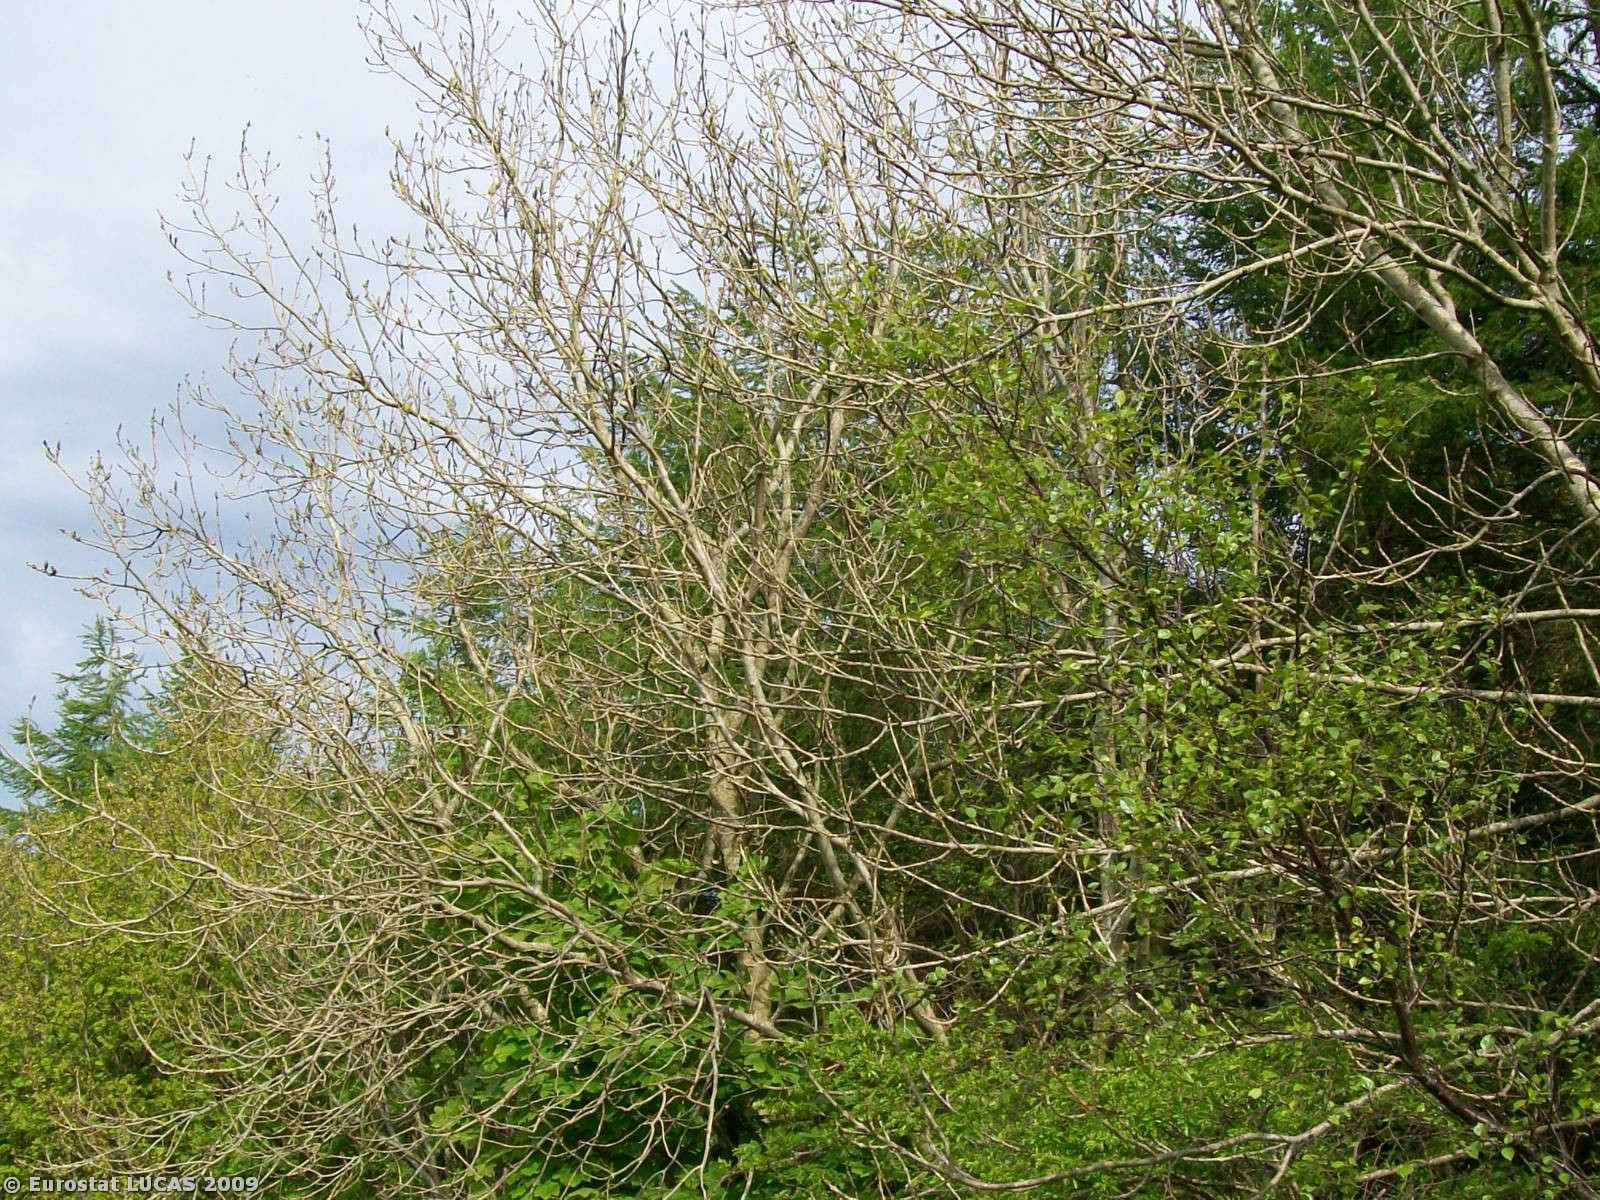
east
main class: Grassland
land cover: Grassland with sparse tree/shrub cover
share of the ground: > 75 %
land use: Agriculture (excluding fallow land and kitchen gardens)
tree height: > 5 m
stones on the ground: < 10 %
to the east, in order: Grassland with sparse tree/shrub cover; Fences; Coniferous woodland; Rivers and streams; Coniferous woodland
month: May
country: GB
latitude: 54.7181
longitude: -3.1935
